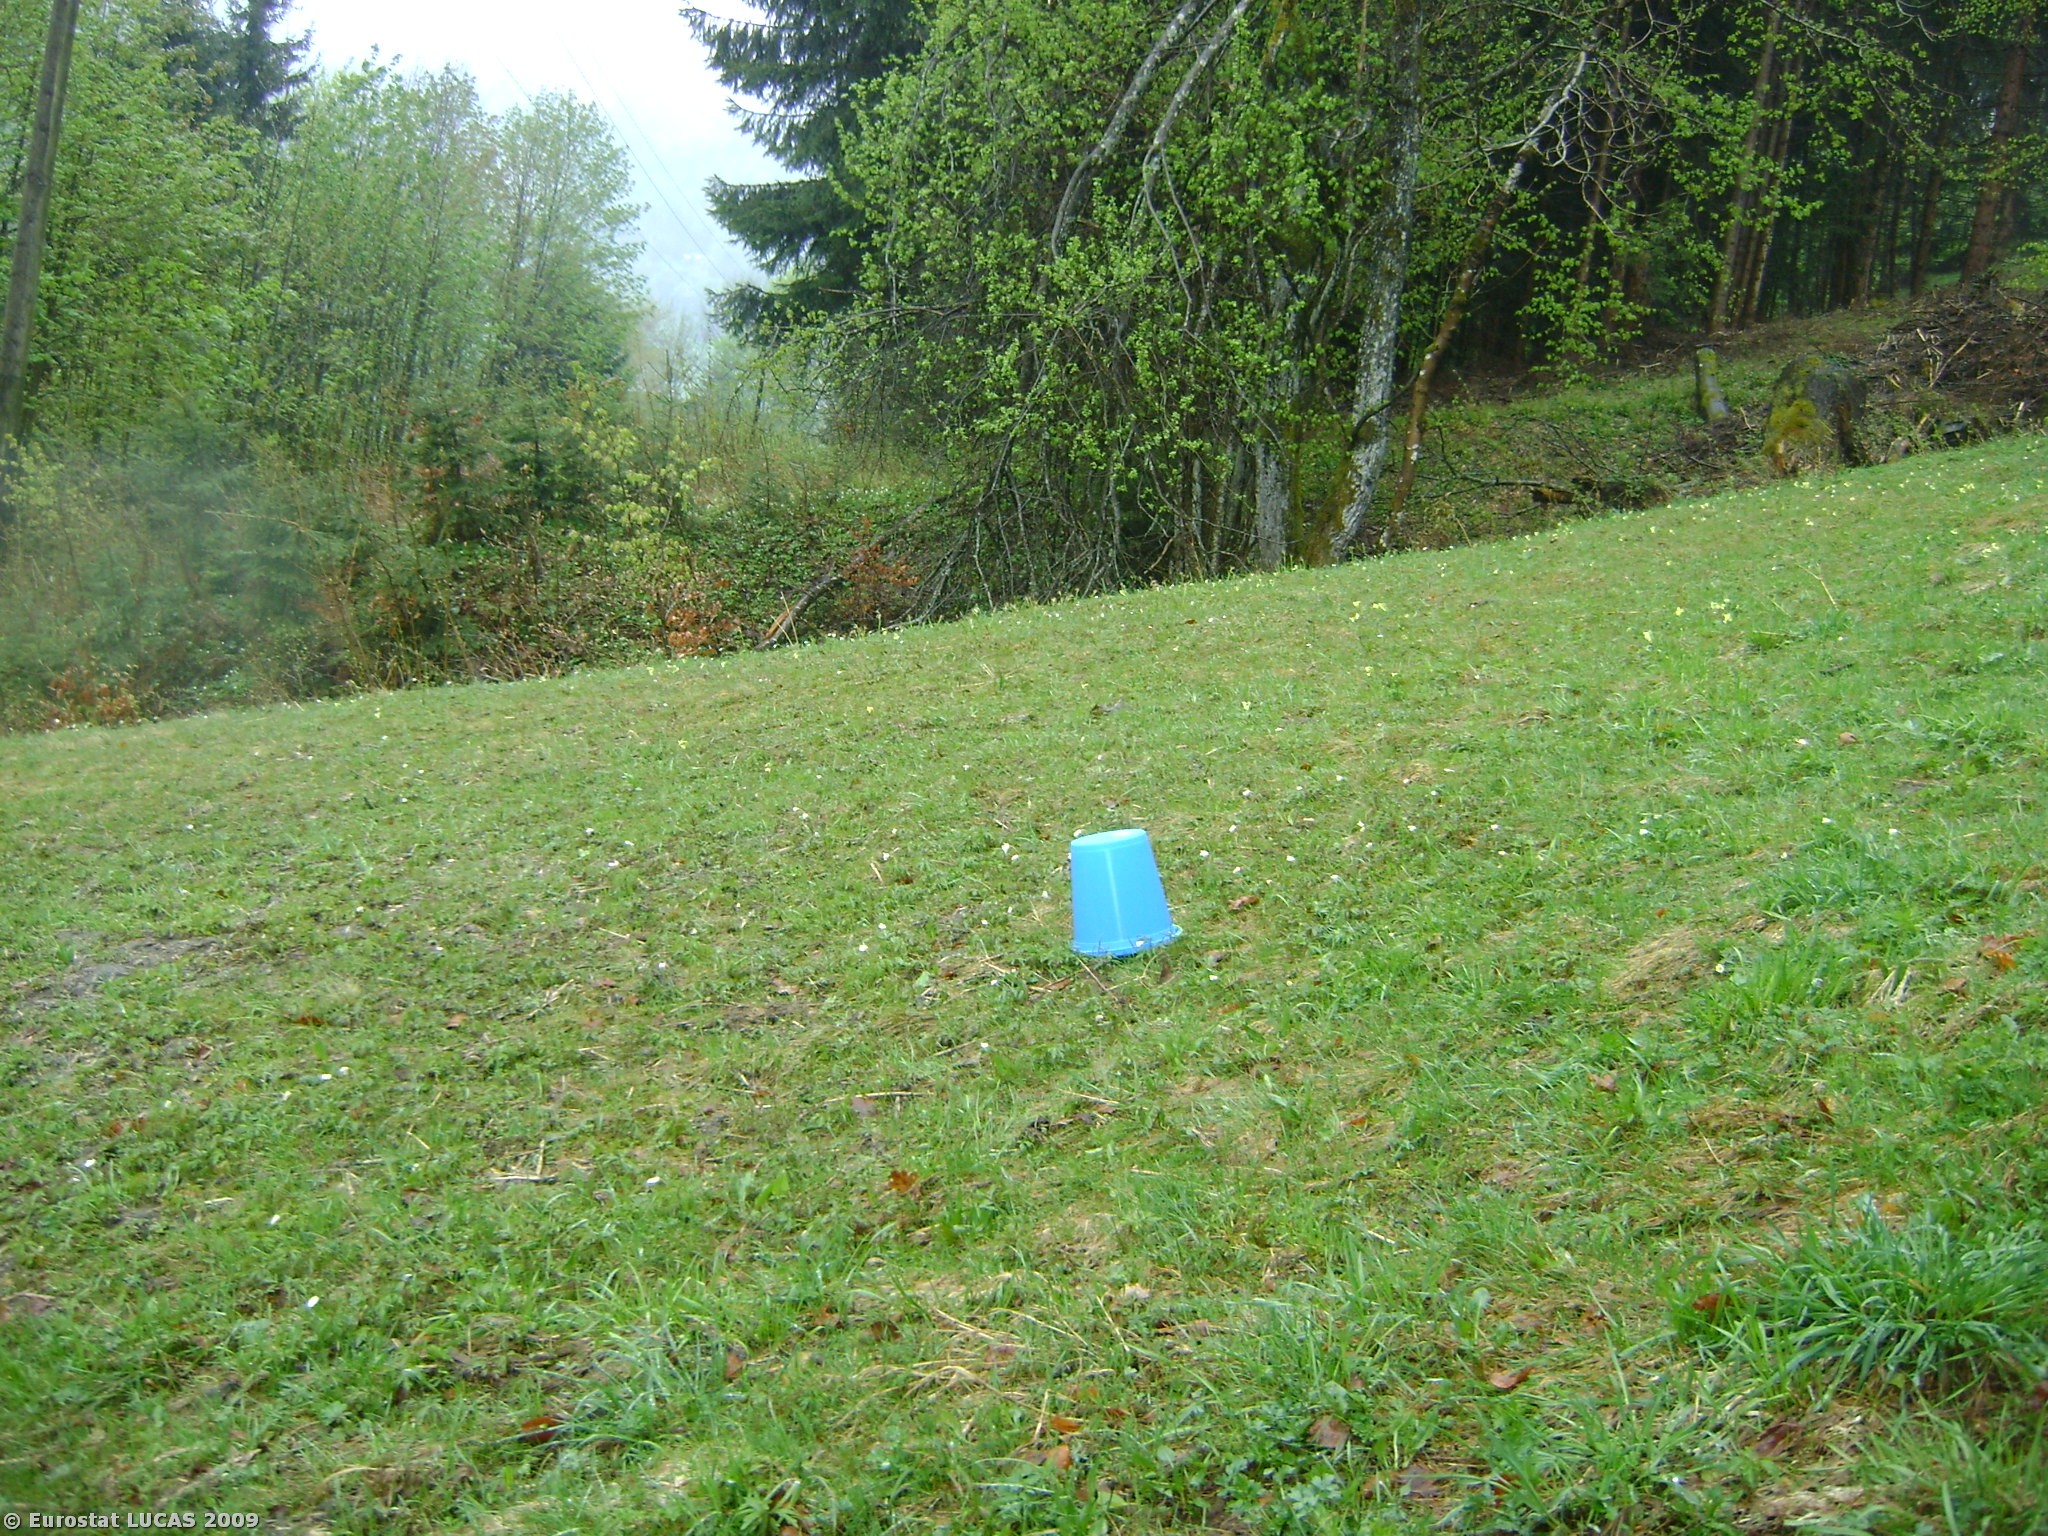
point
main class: Grassland
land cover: Grassland without tree/shrub cover
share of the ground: > 75 %
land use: Agriculture (excluding fallow land and kitchen gardens)
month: May
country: AT
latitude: 47.7976
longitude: 13.2429
